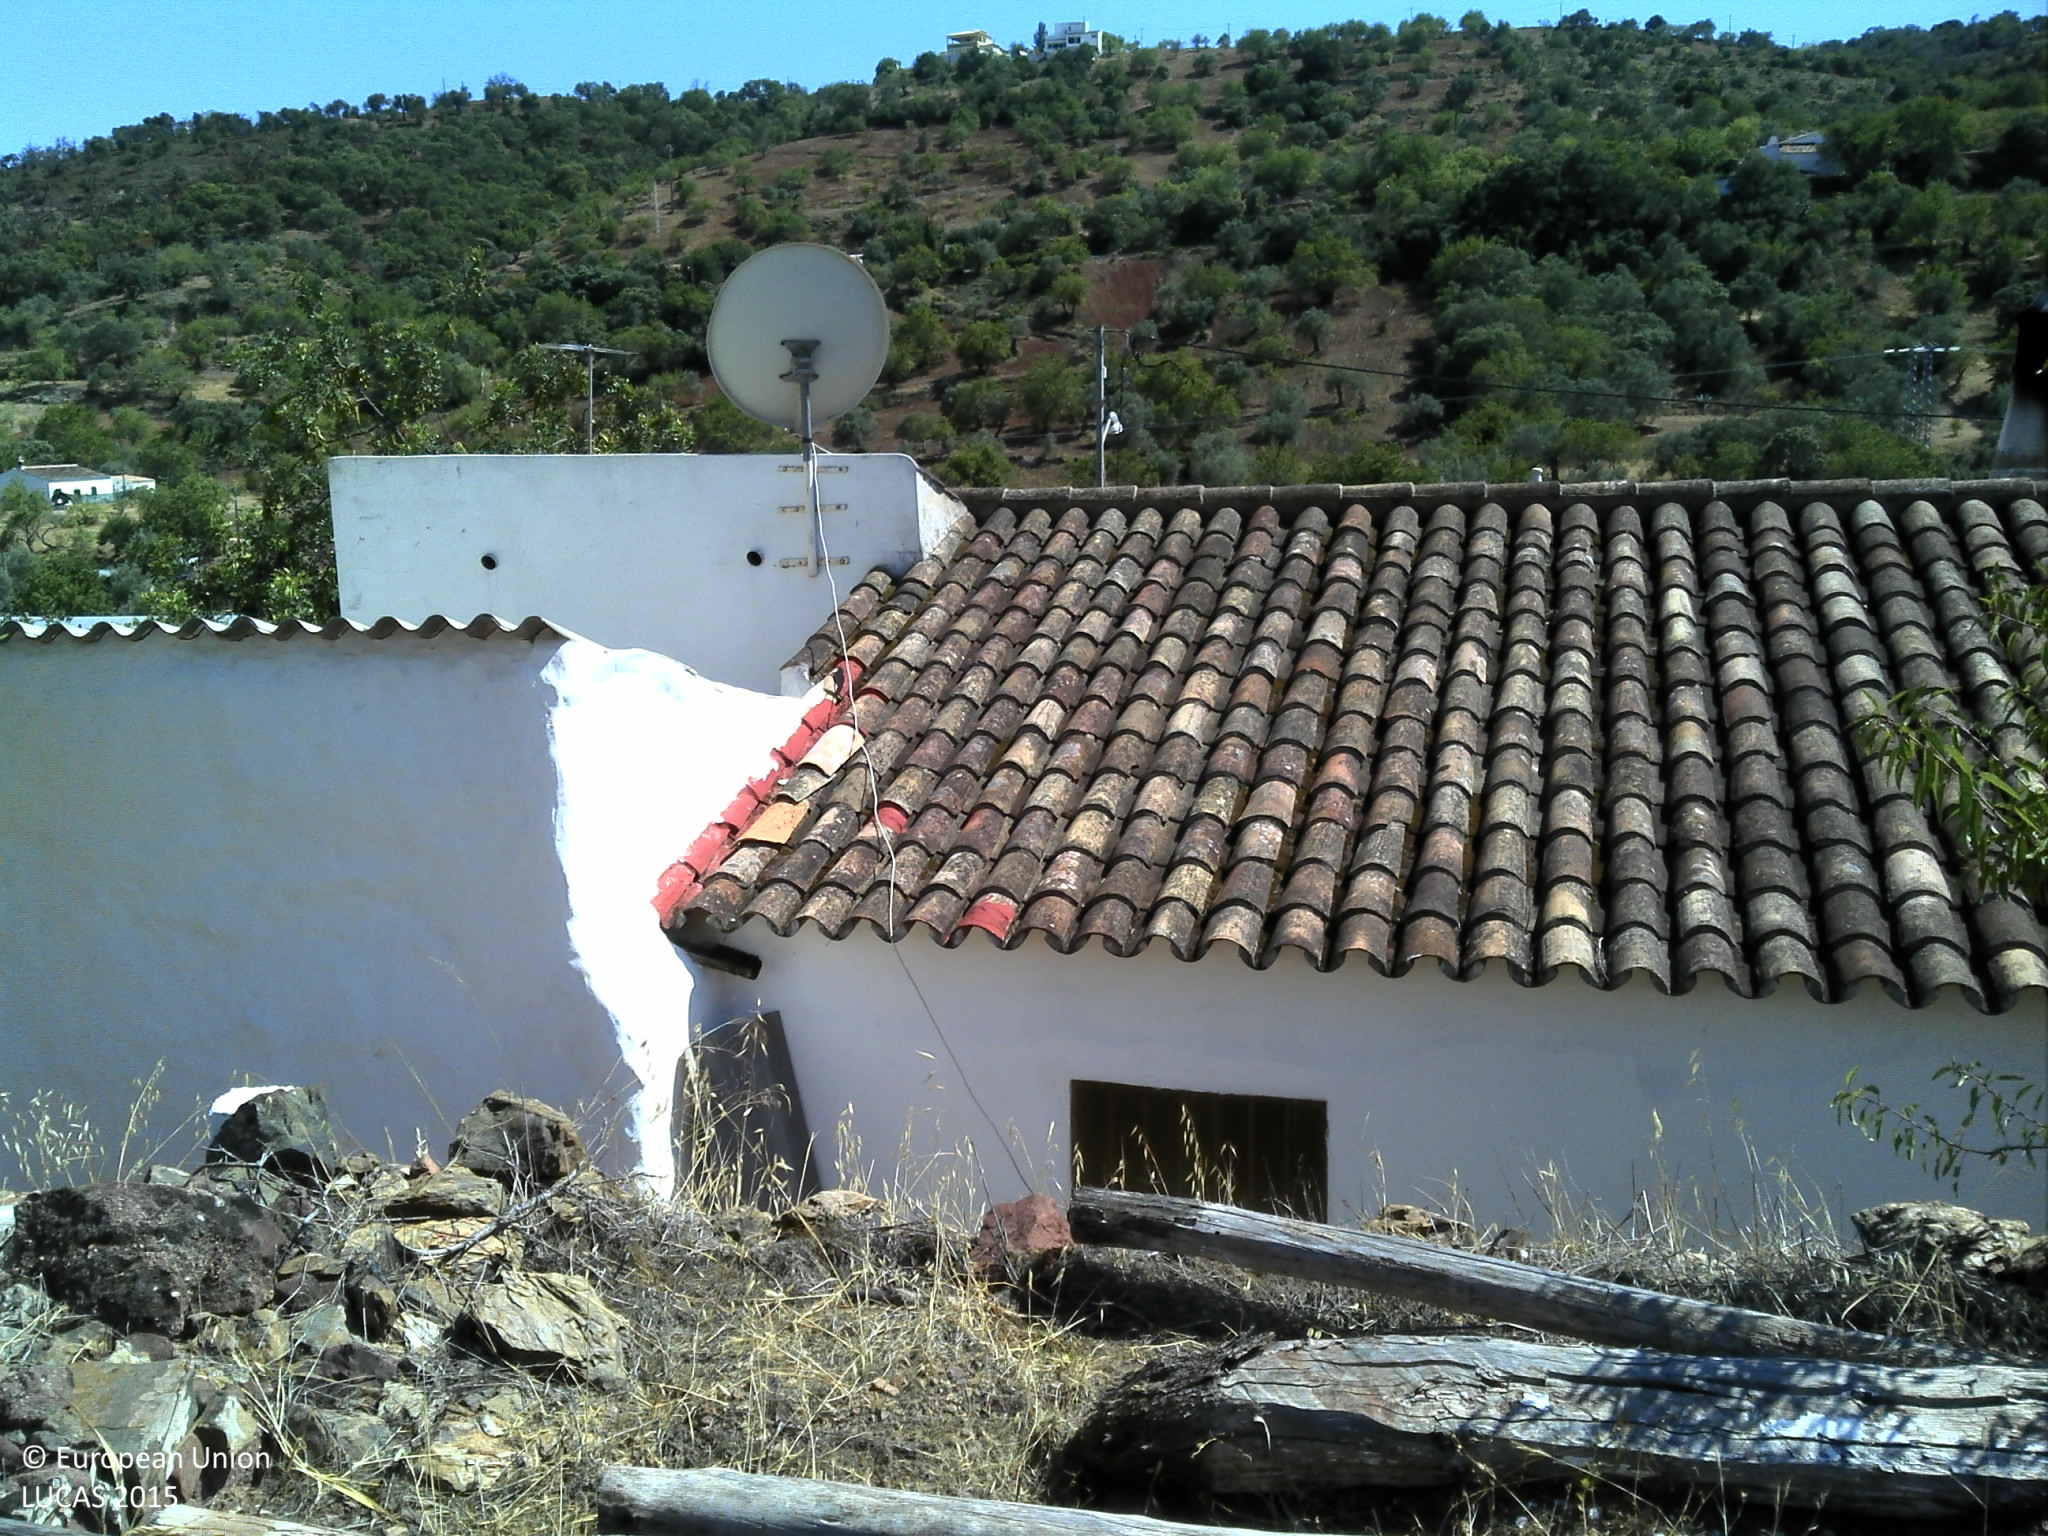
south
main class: Grassland
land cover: Grassland with sparse tree/shrub cover
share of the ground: > 75 %
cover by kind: herbaceous plants 85 %, unconsolidated bare surface 10 %, broadleaved forest trees 5 %
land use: Agriculture (excluding fallow land and kitchen gardens)
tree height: < 5 m
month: June
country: PT
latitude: 37.1575
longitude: -7.8345
